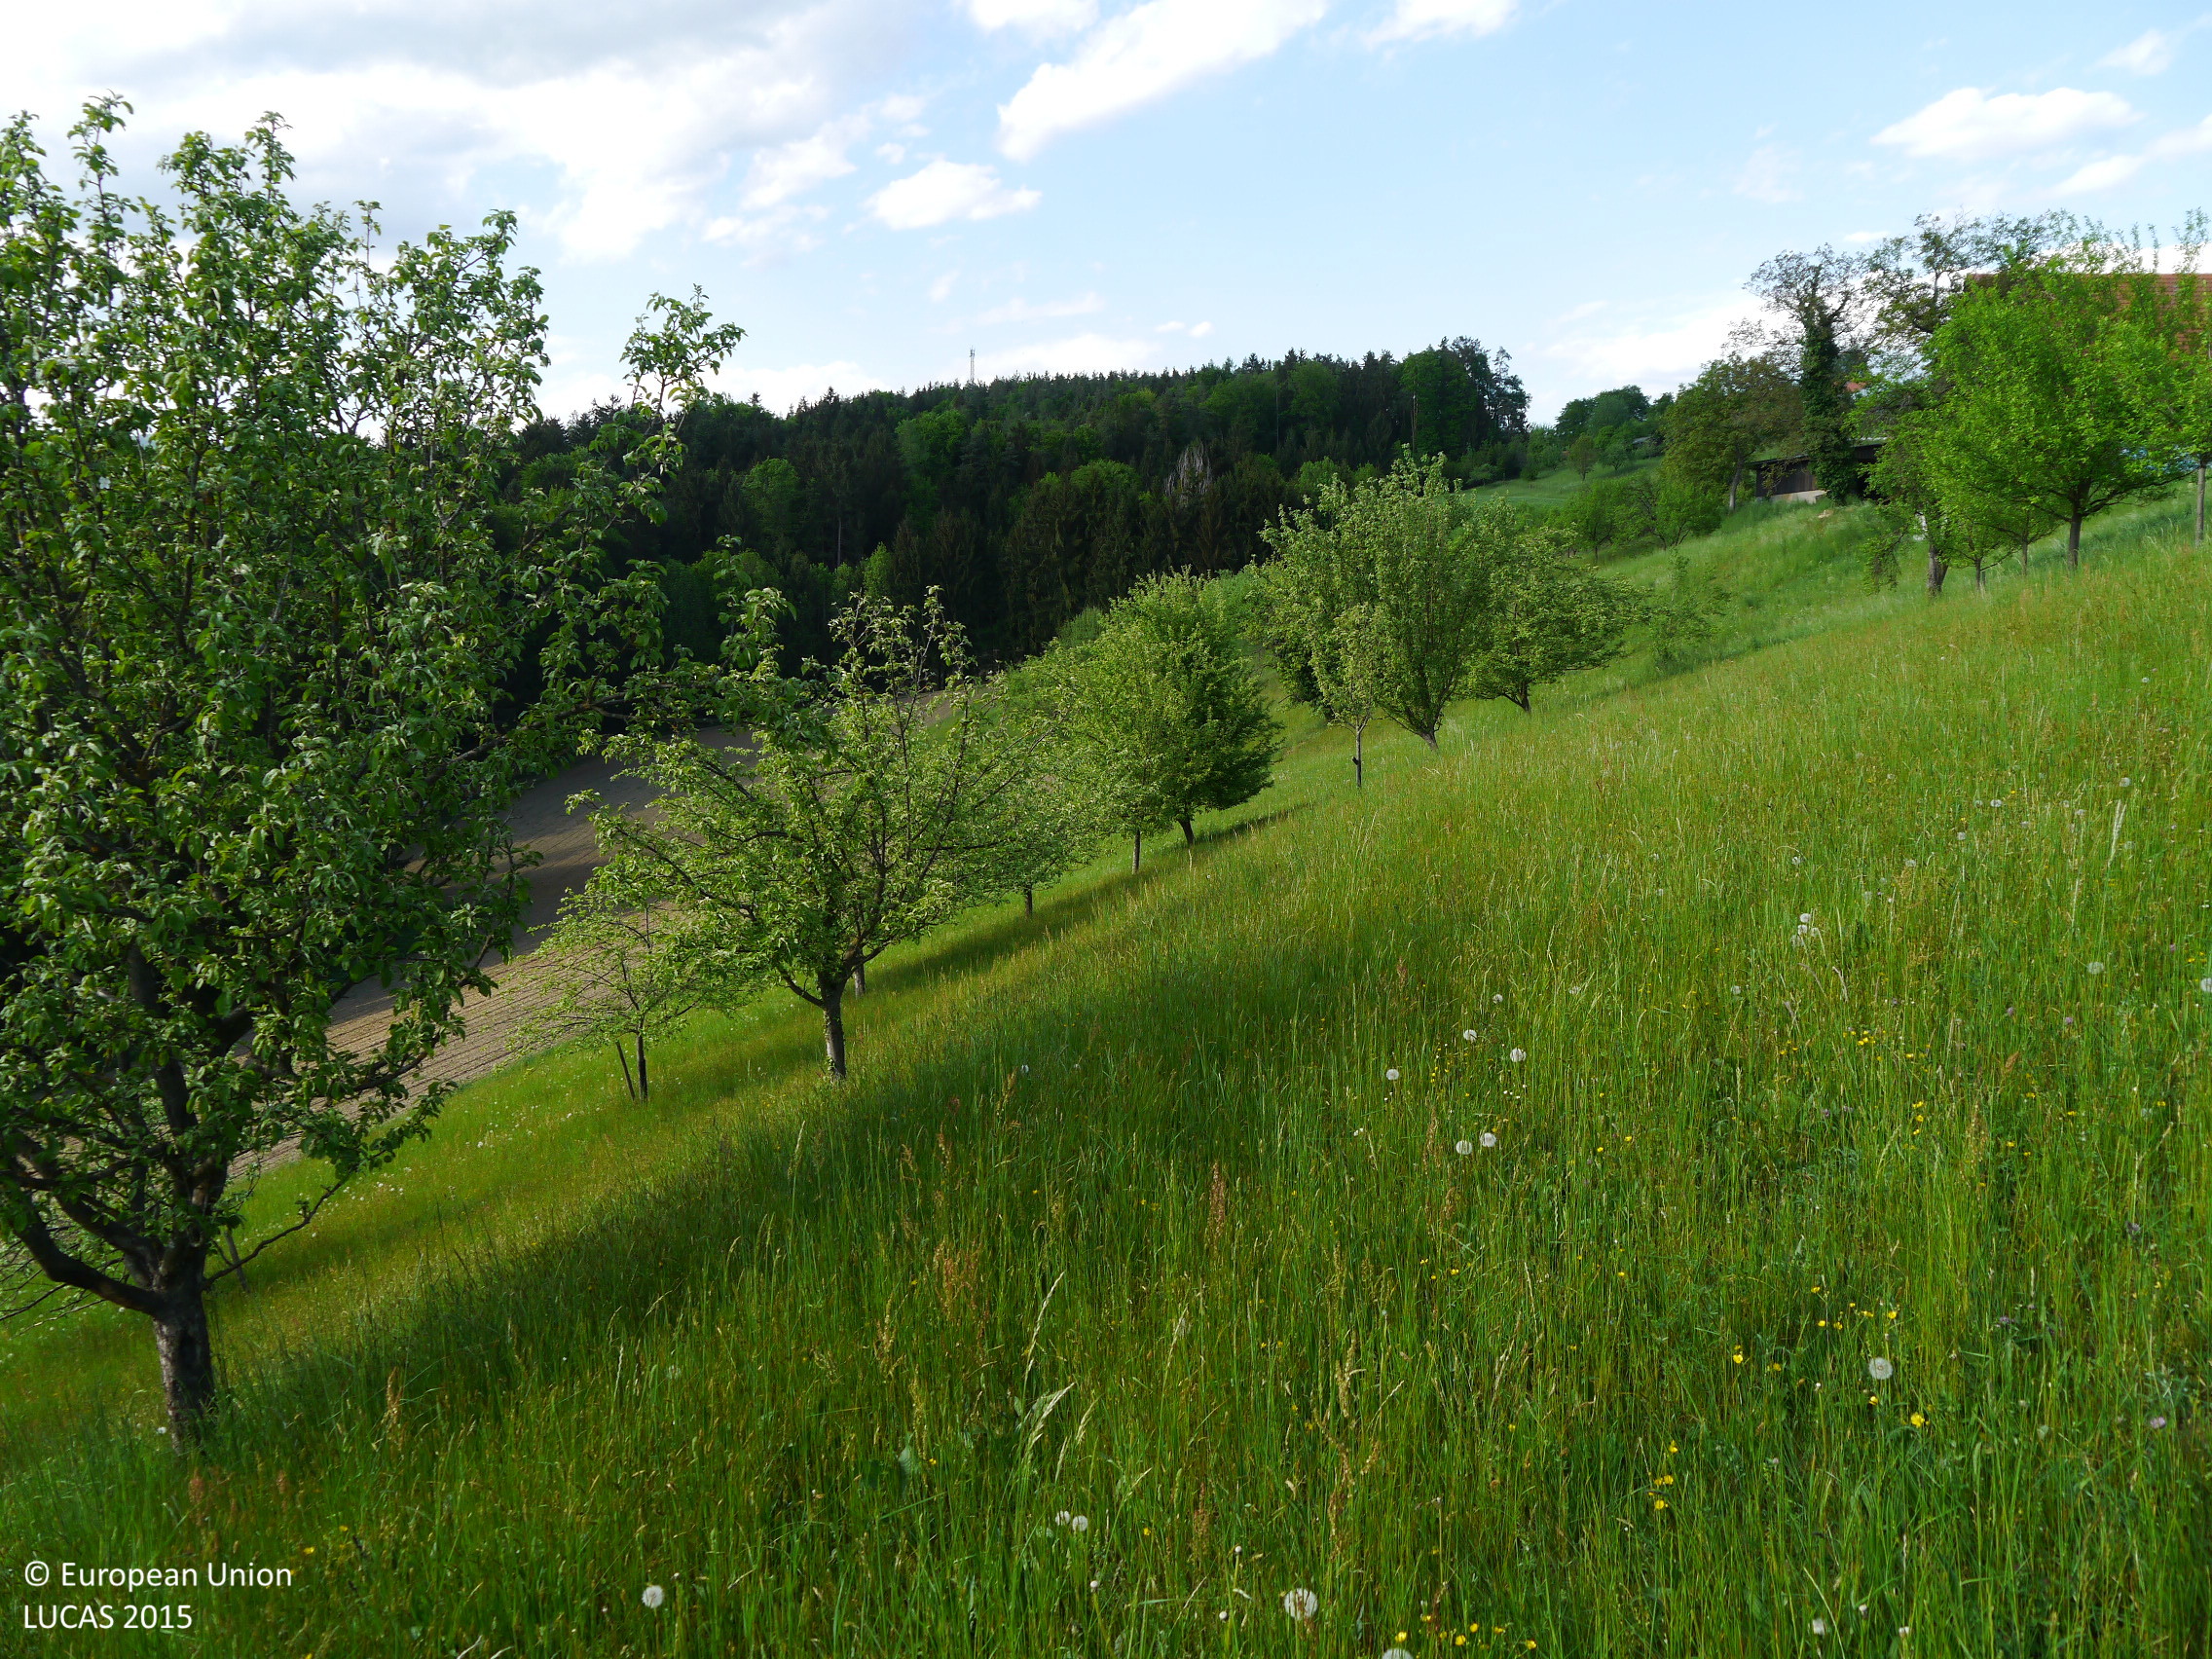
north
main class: Cropland
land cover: Apple fruit
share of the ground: 50 - 75 %
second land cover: Grassland without tree/shrub cover
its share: > 75 %
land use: Agriculture (excluding fallow land and kitchen gardens)
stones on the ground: < 10 %
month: May
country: AT
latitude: 47.0690
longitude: 15.2799
